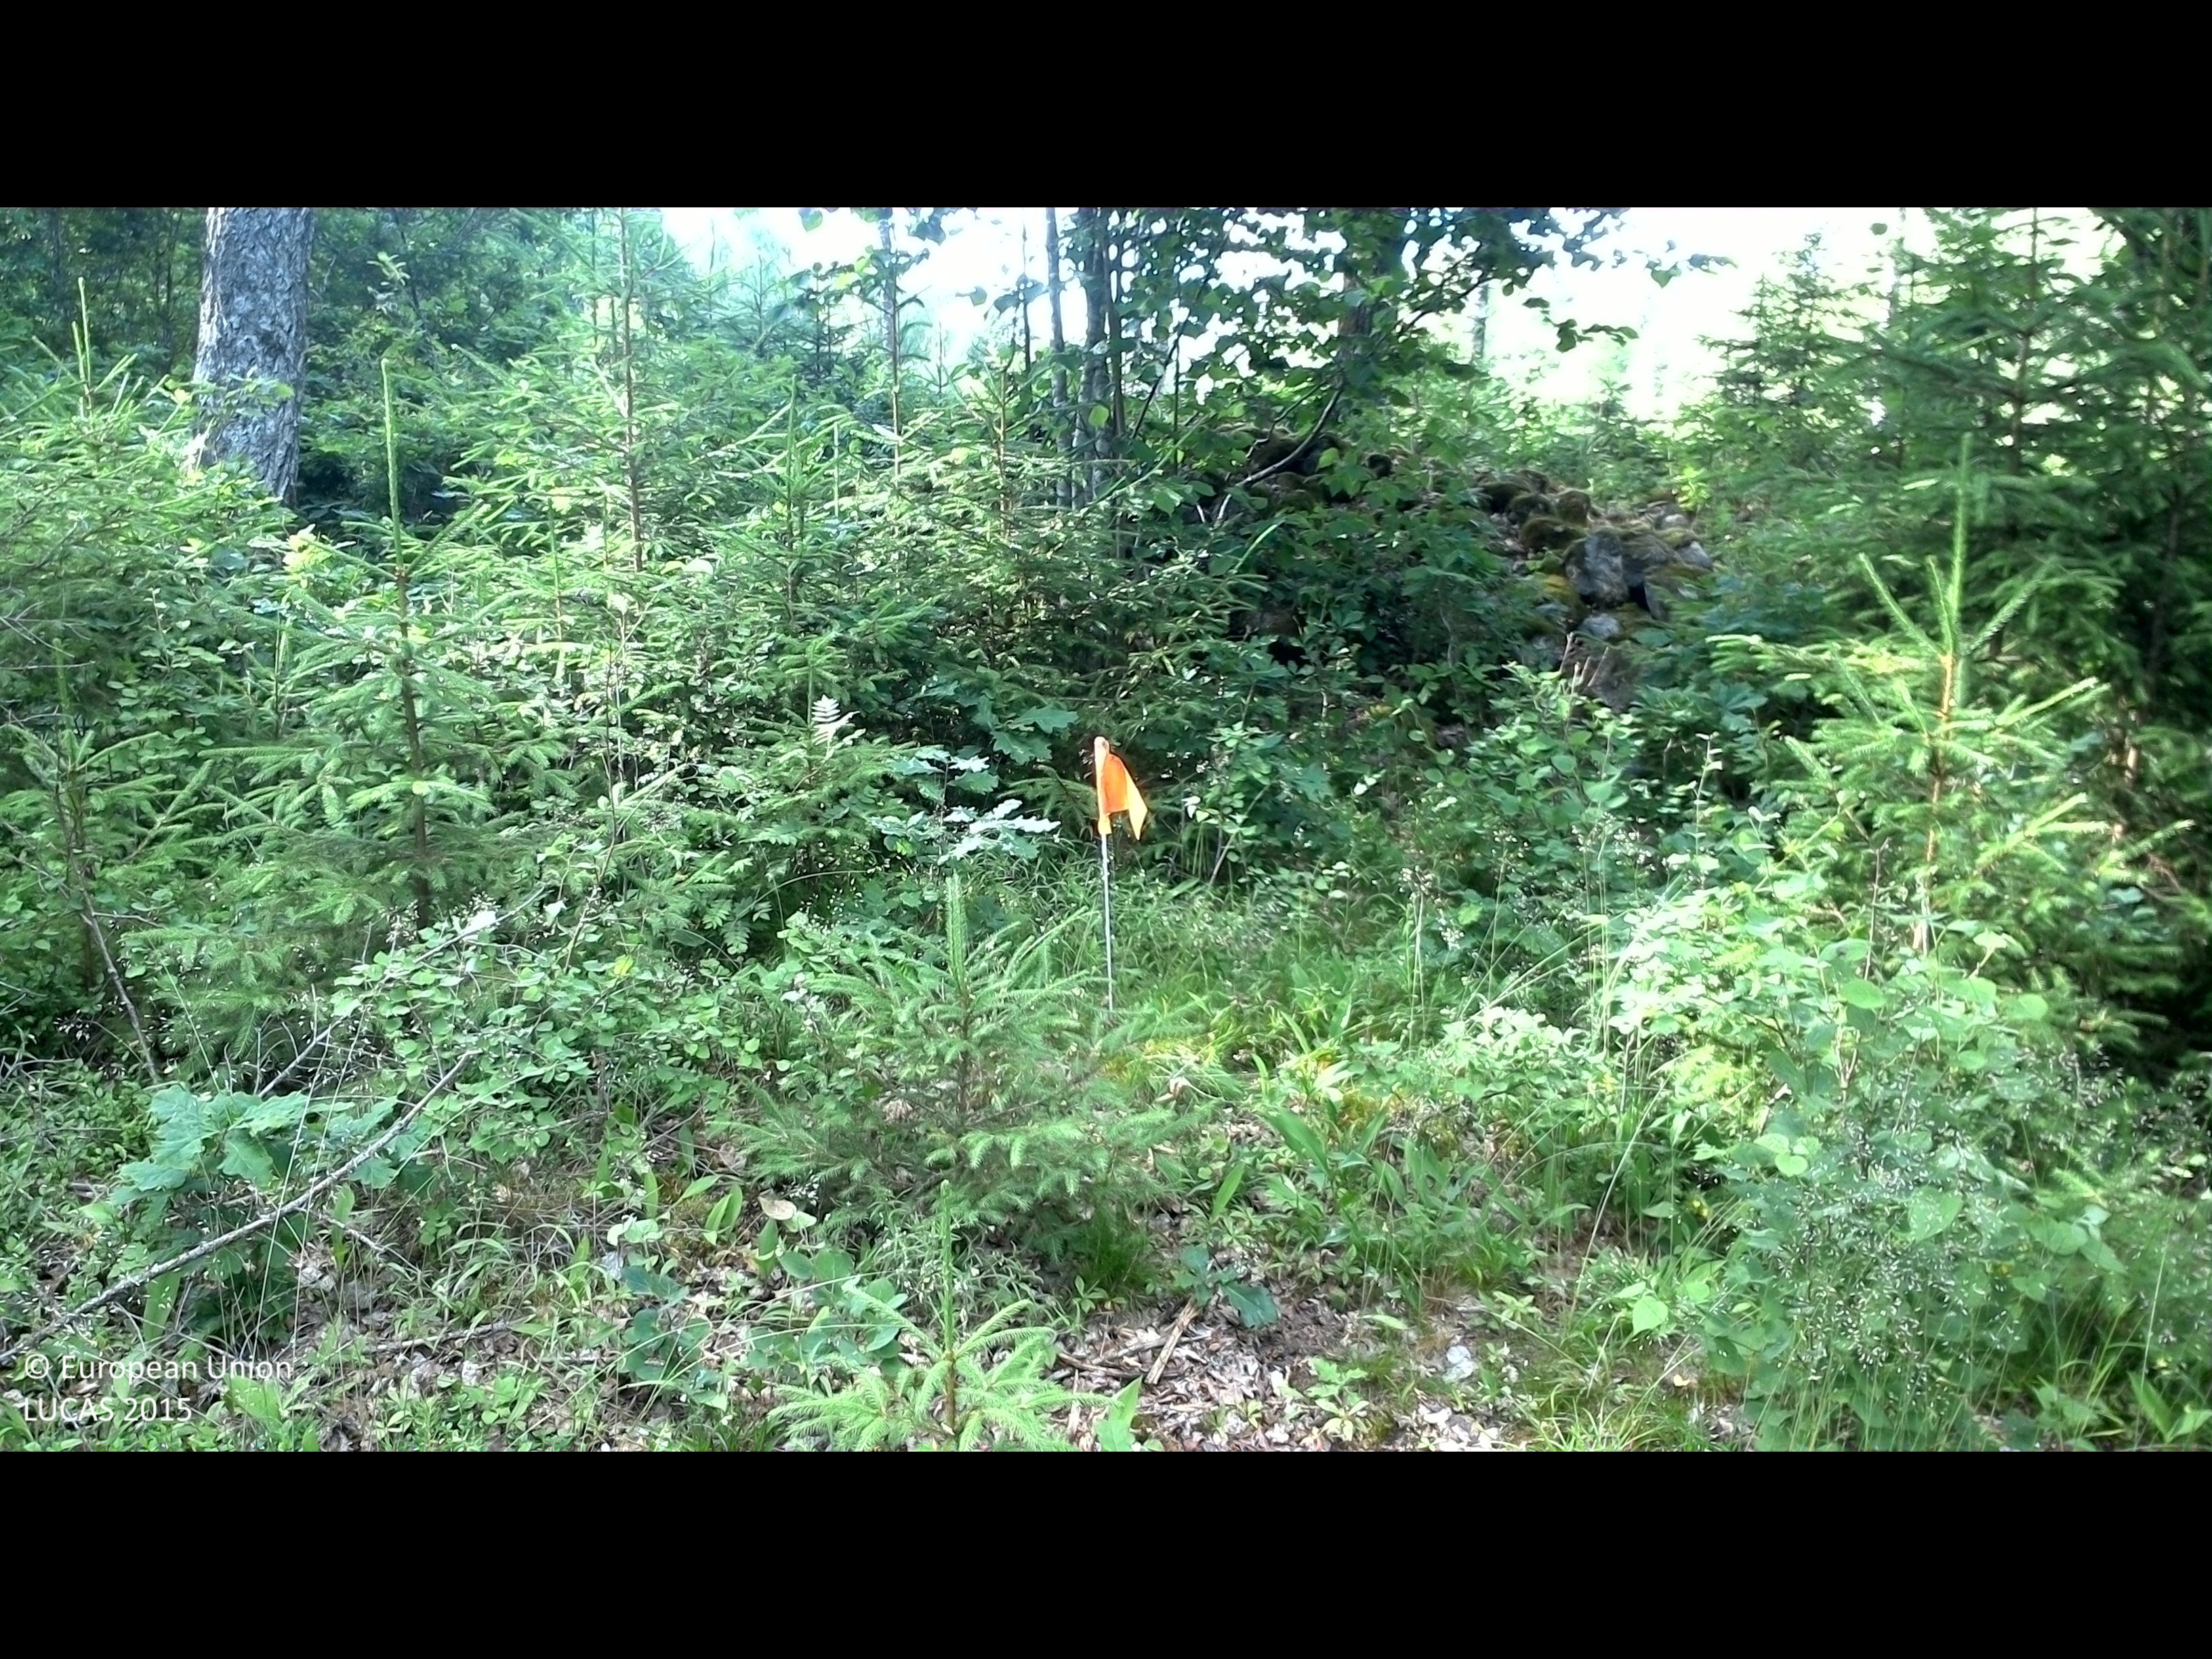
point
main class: Woodland
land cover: Broadleaved woodland
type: hemiboreal forest and nemoral coniferous forest and mixed broadleaved-coniferous forest
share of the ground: 50 - 75 %
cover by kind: broadleaved forest trees 65 %, shrubs 15 %, coniferous forest trees 10 %, herbaceous plants 10 %
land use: Forestry
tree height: > 5 m
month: July
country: SE
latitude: 56.4490
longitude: 15.0438
